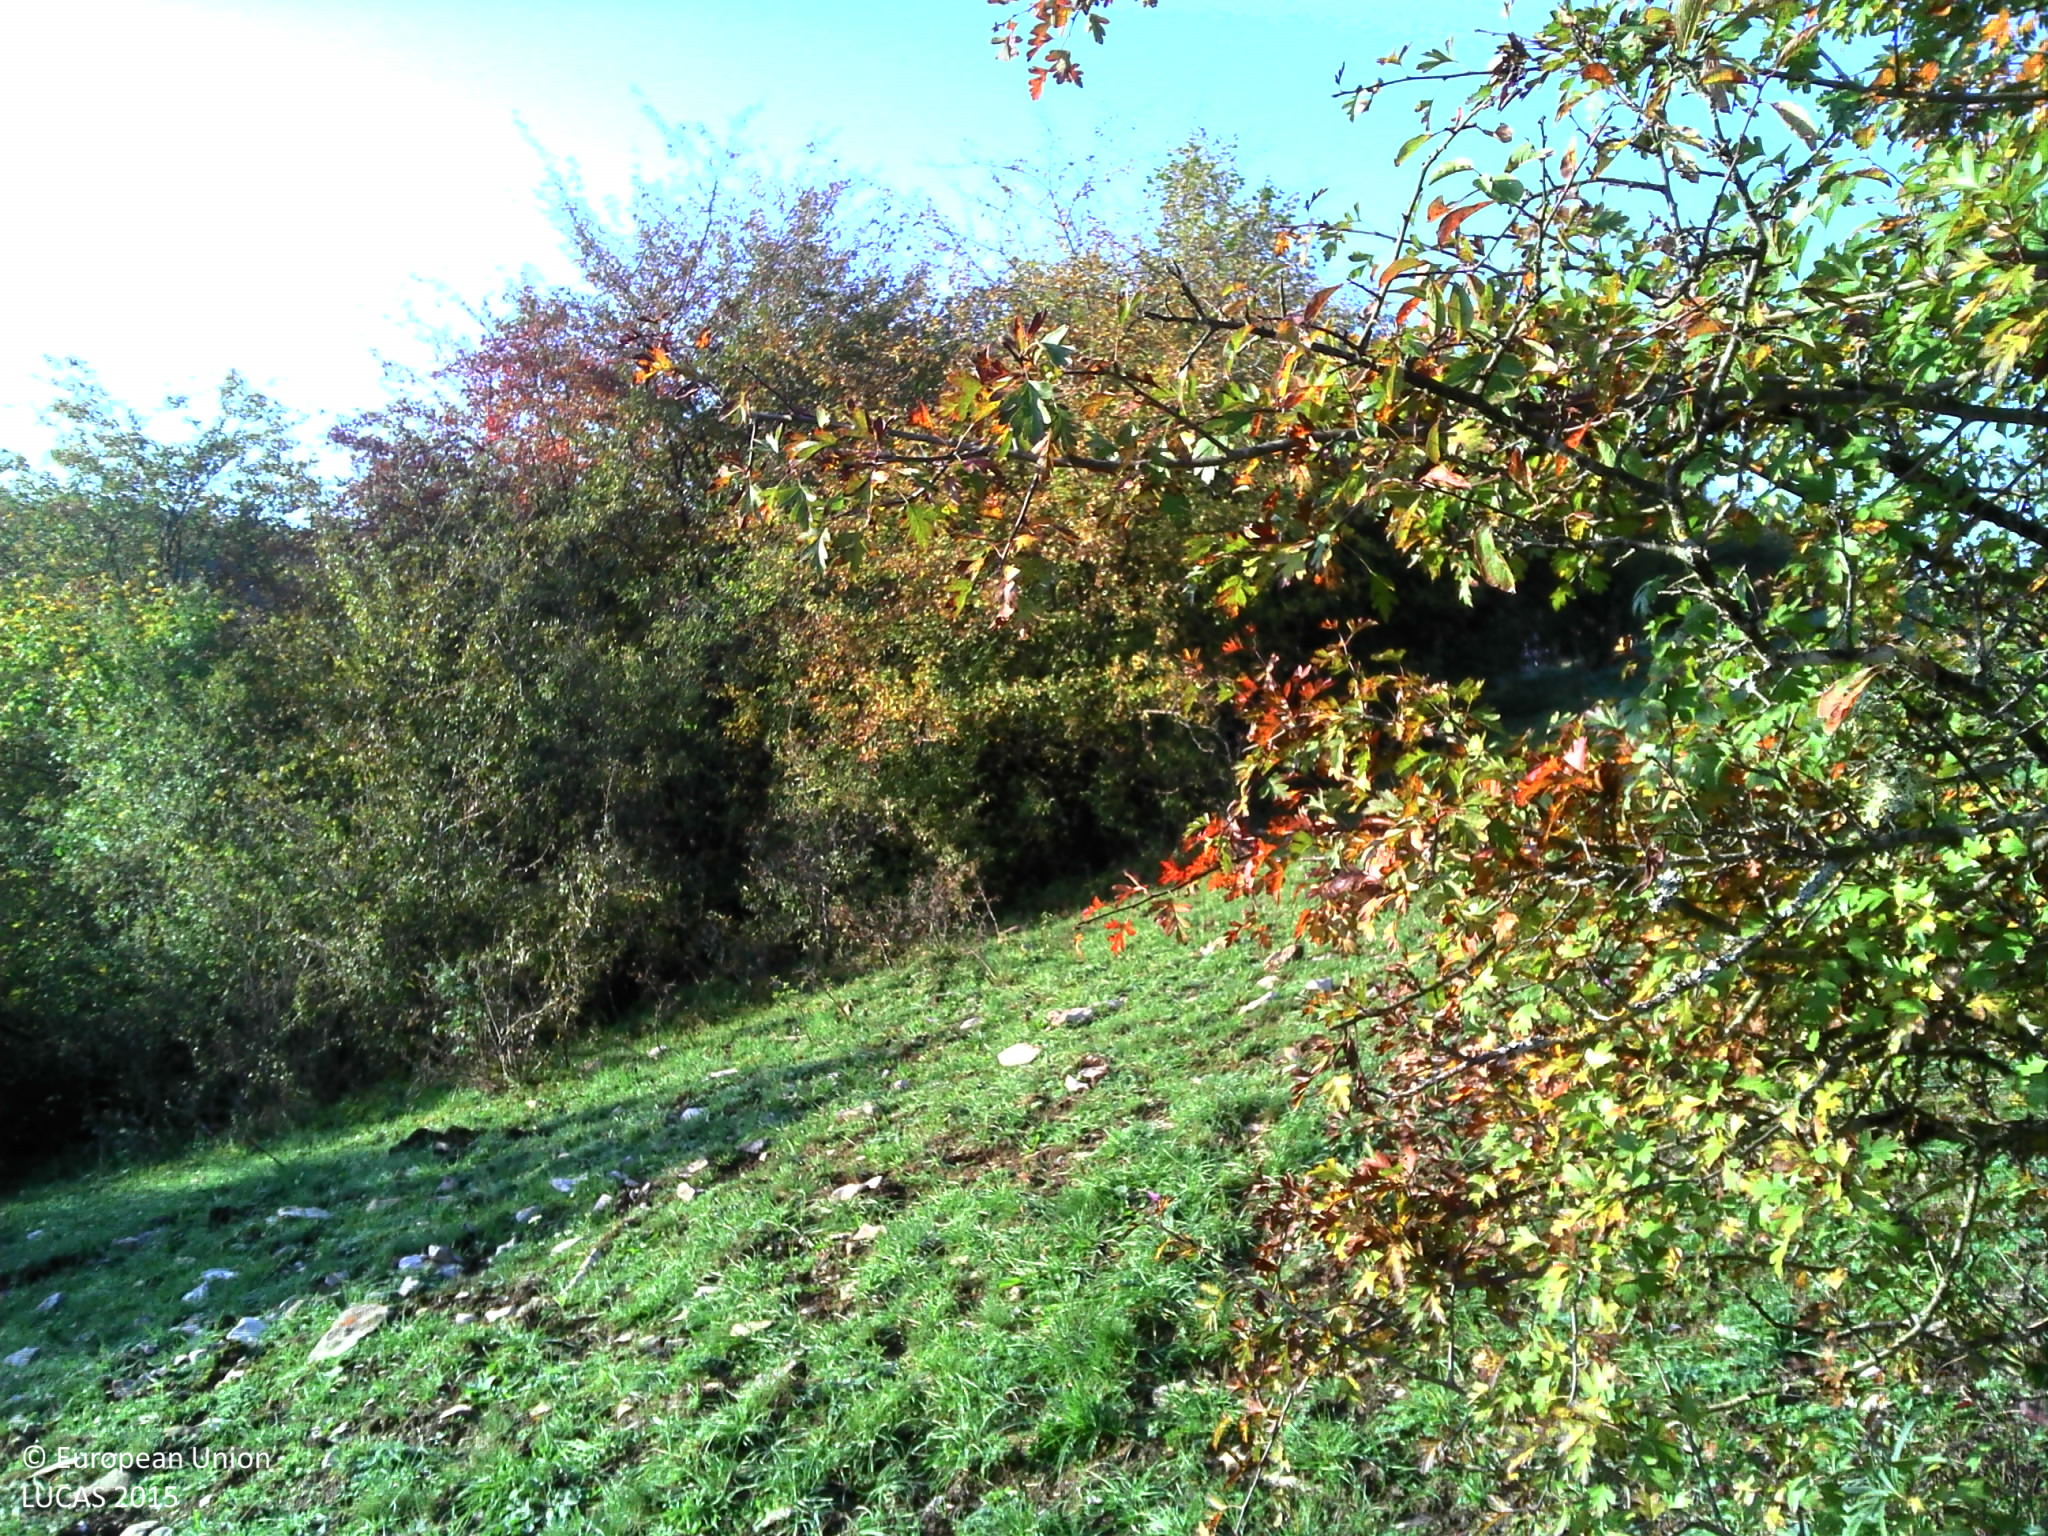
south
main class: Shrubland
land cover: Shrubland with sparse tree cover
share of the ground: > 75 %
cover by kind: shrubs 50 %, herbaceous plants 45 %, broadleaved forest trees 5 %
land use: Semi-natural and natural areas not in use
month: October
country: FR
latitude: 47.1610
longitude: 6.0315
